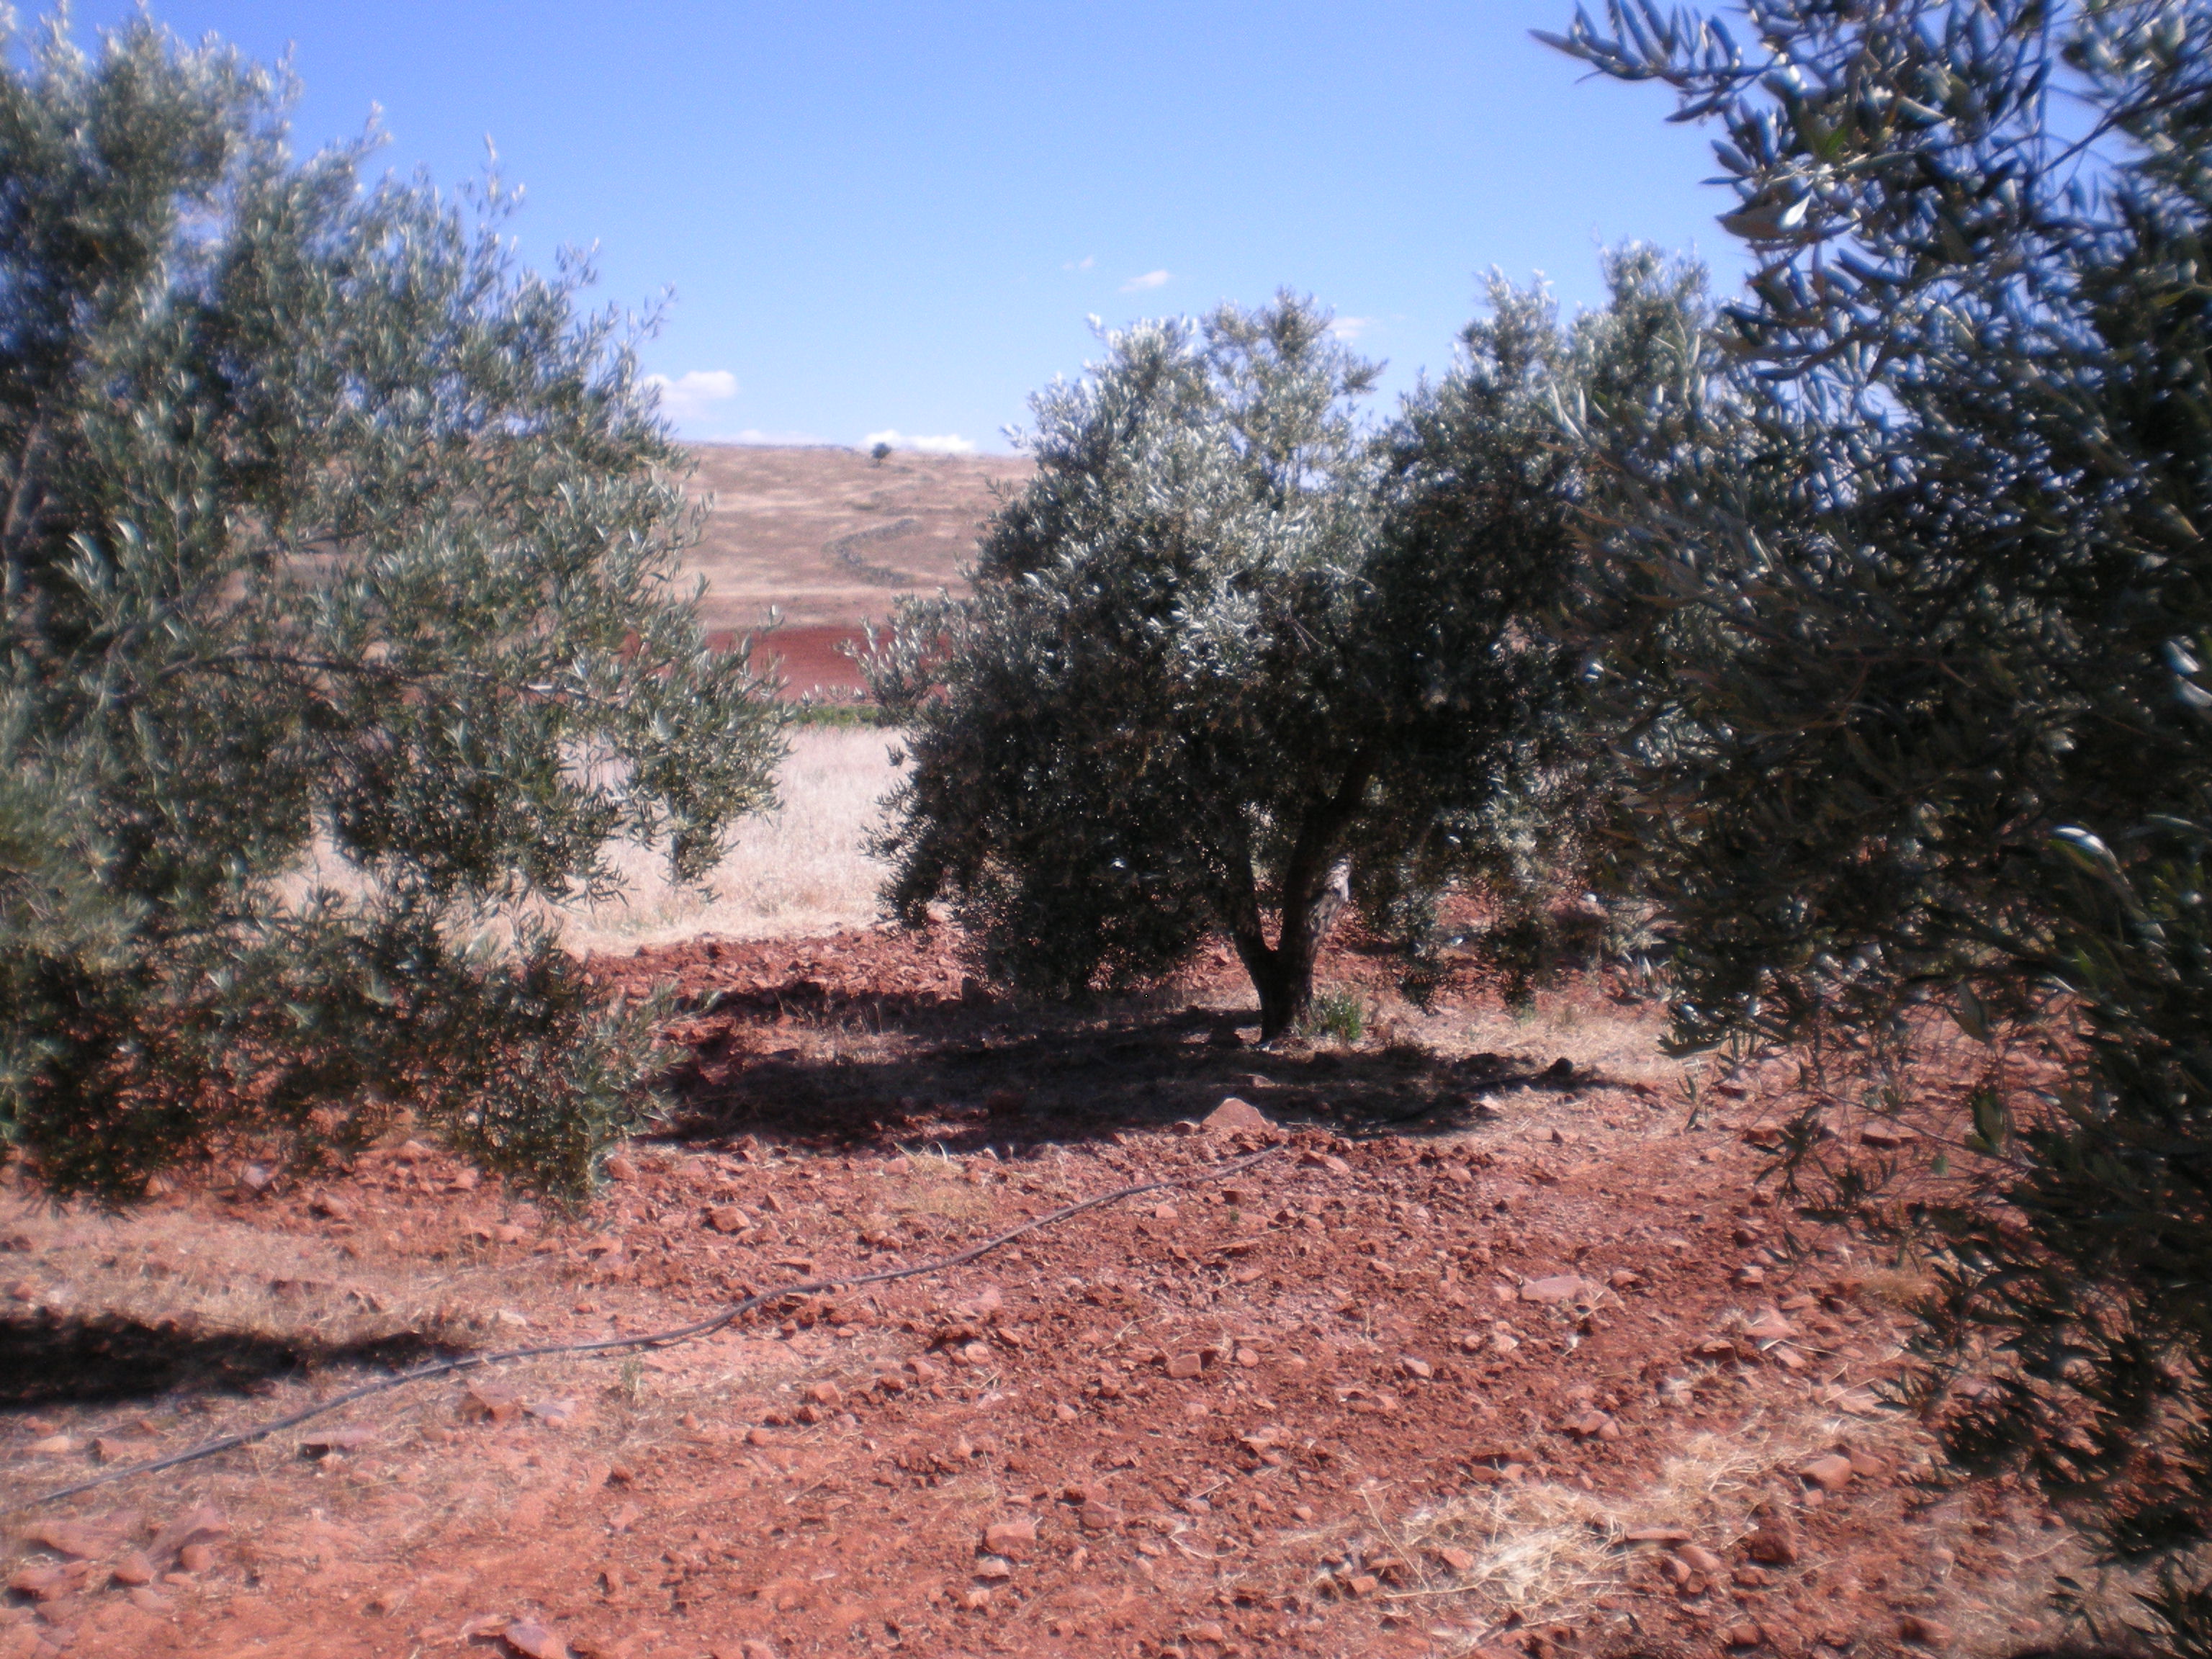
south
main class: Cropland
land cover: Olive groves
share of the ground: 10 - 25 %
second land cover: Other bare soil
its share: > 75 %
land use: Agriculture (excluding fallow land and kitchen gardens)
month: May
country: ES
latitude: 38.7255
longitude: -3.3645
